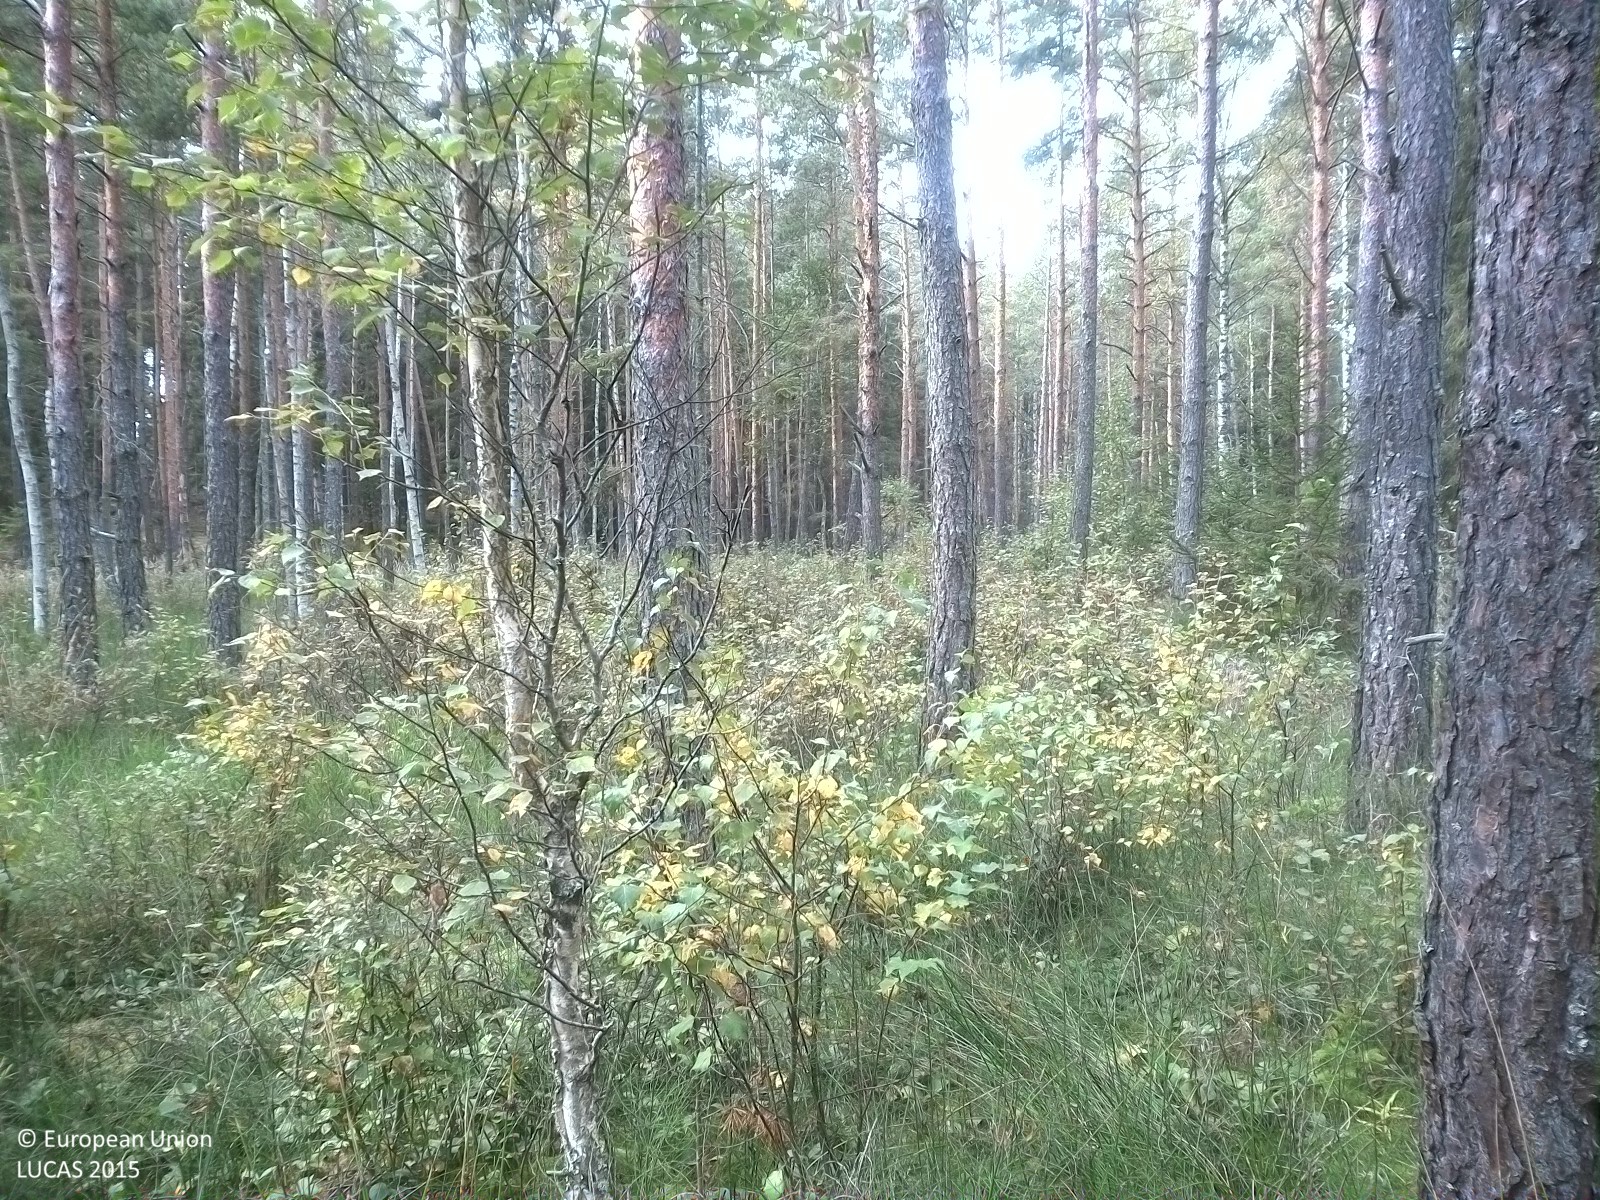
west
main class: Woodland
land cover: Pine dominated mixed woodland
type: boreal forest
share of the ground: 25 - 50 %
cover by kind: herbaceous plants 35 %, lichens and mosses 25 %, coniferous forest trees 20 %, broadleaved forest trees 15 %, shrubs 5 %
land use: Semi-natural and natural areas not in use
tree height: > 5 m
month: September
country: SE
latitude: 58.5347
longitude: 16.4369
